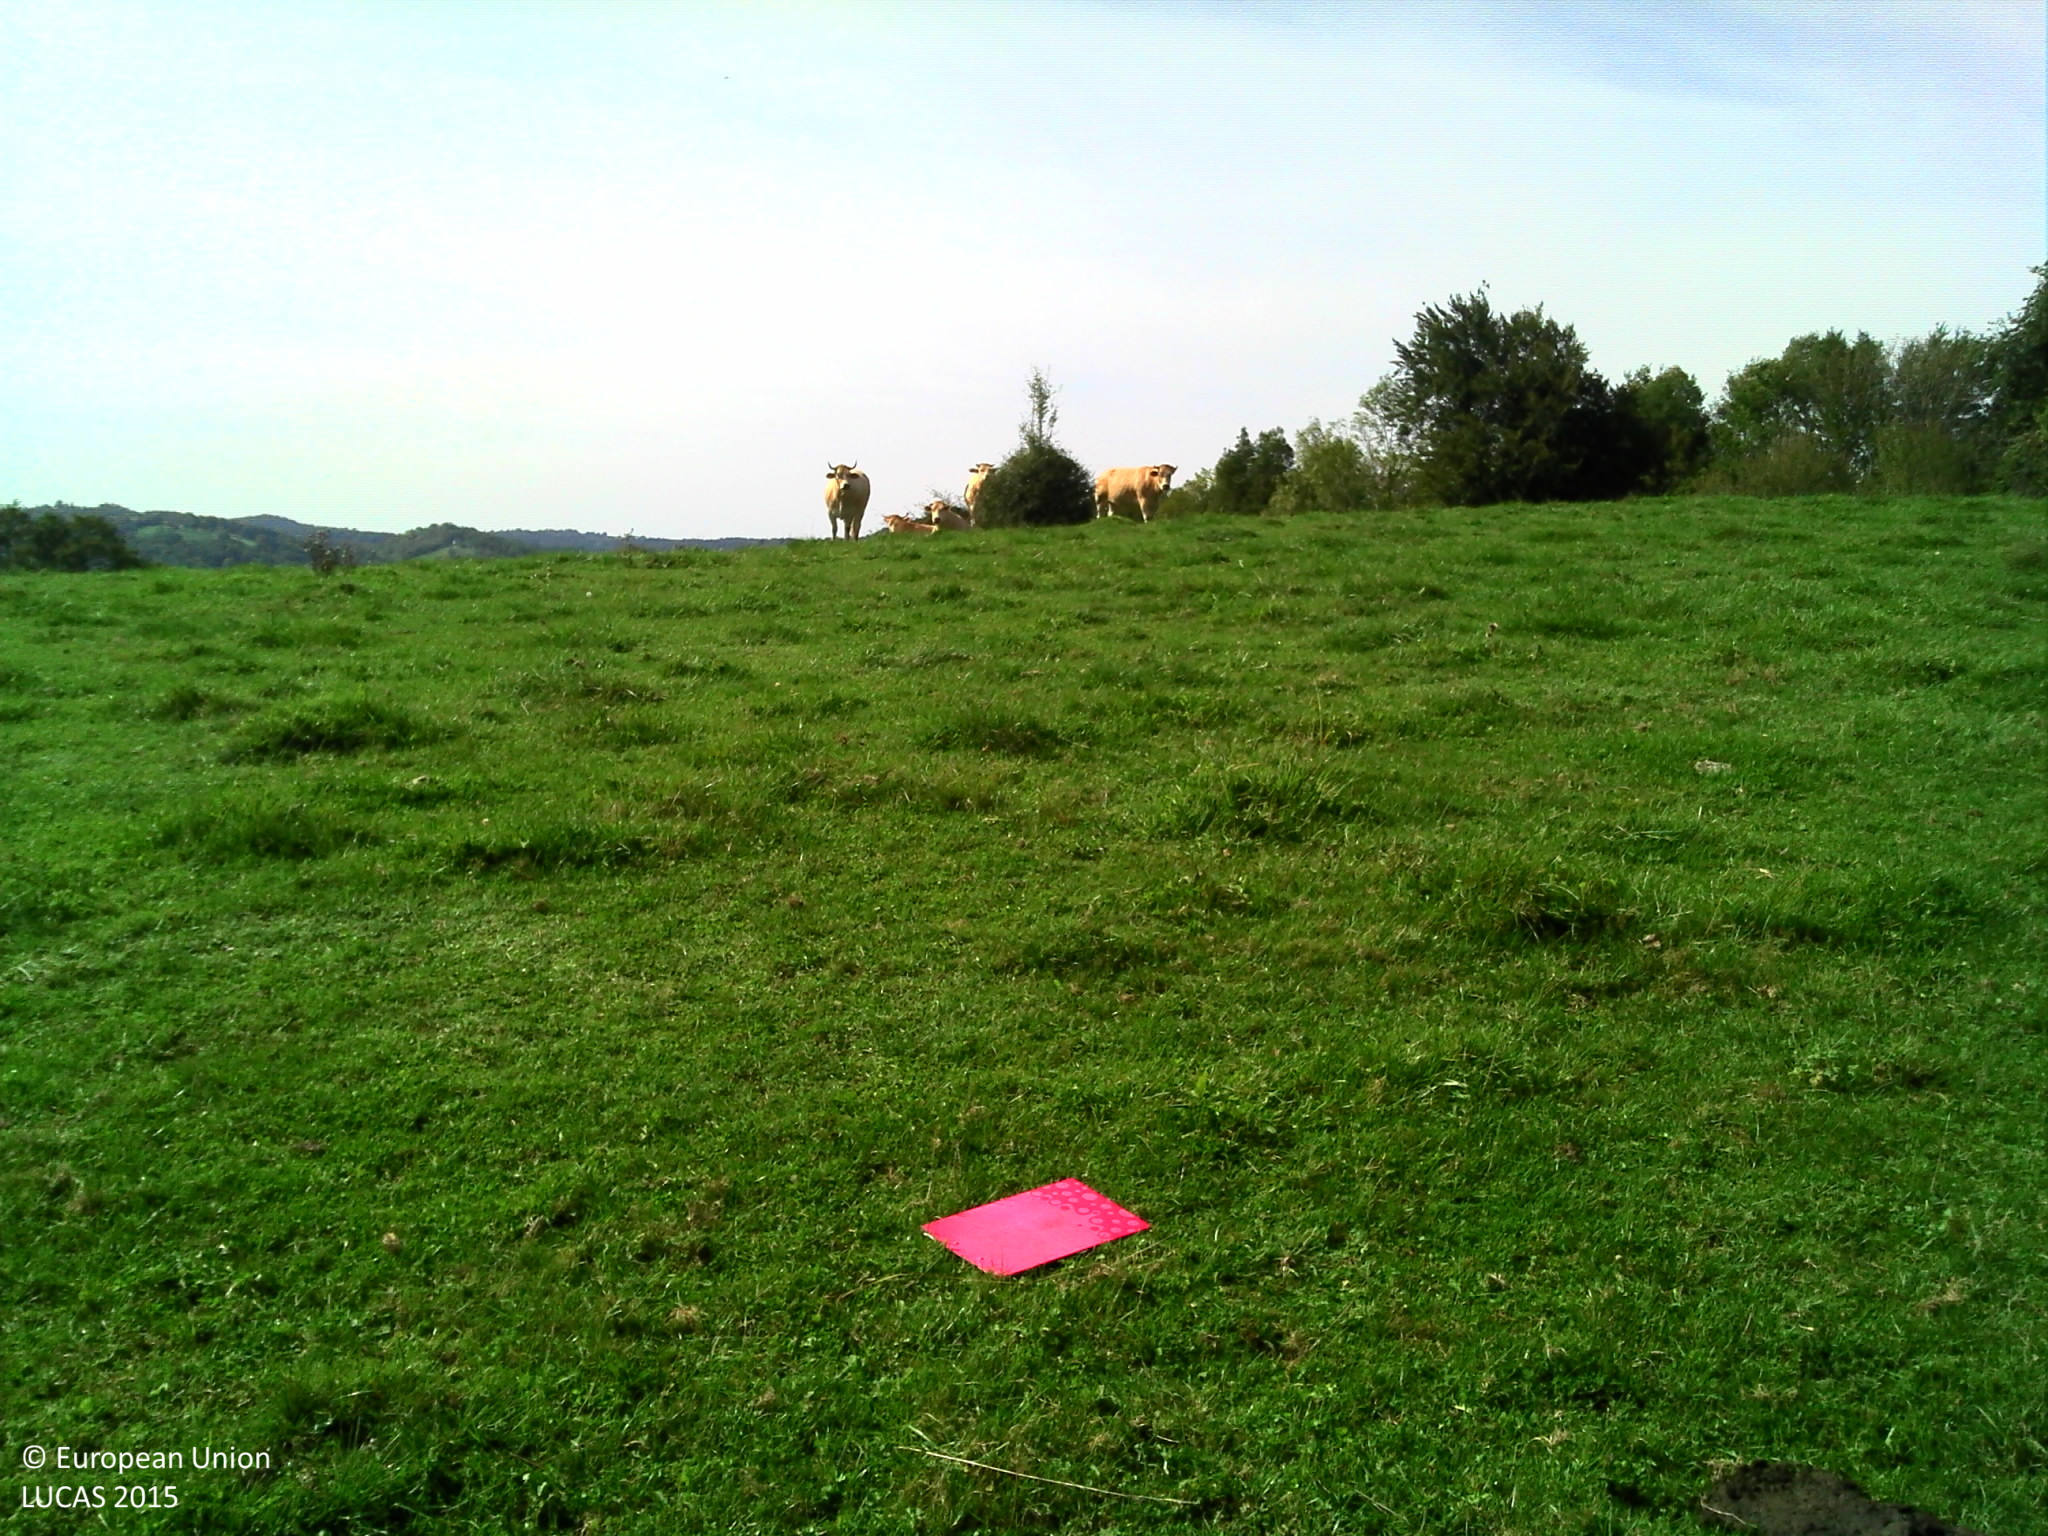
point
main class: Grassland
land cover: Grassland without tree/shrub cover
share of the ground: > 75 %
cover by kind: herbaceous plants 100 %
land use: Agriculture (excluding fallow land and kitchen gardens)
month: September
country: FR
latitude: 43.2207
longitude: -0.4589
